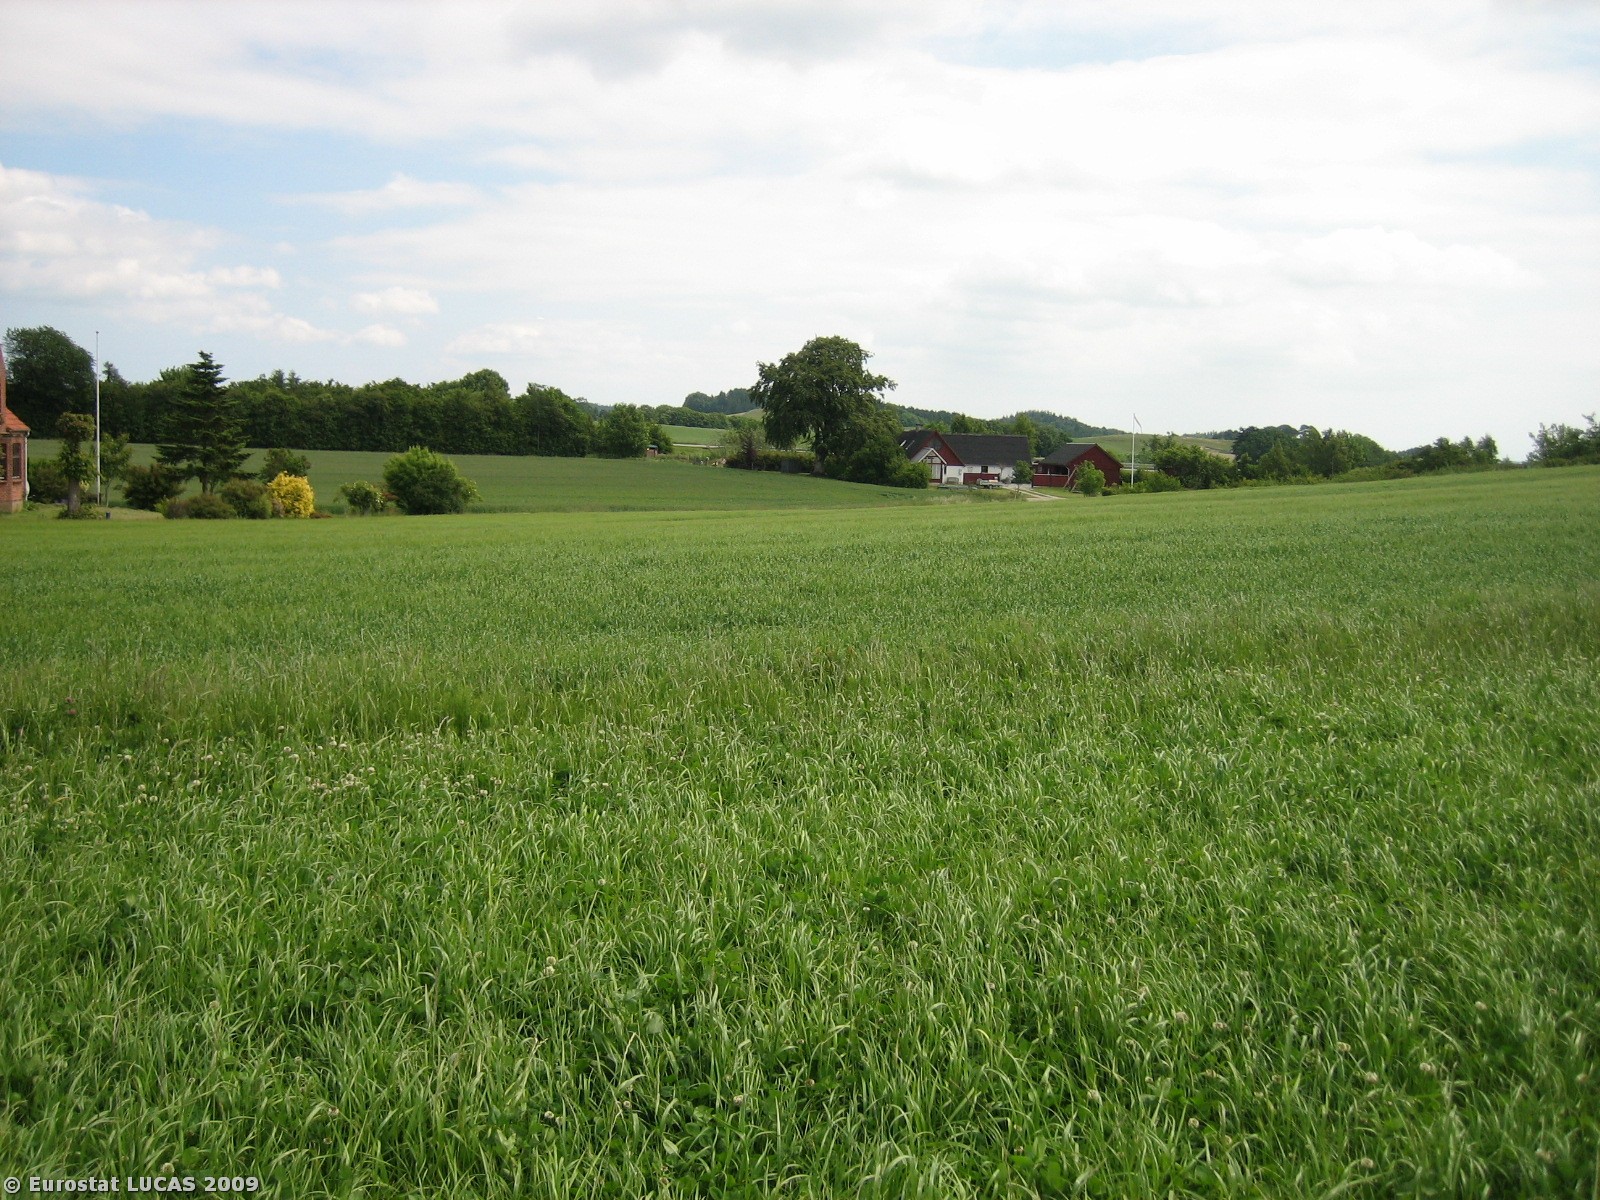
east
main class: Cropland
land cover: Temporary grasslands
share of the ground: > 75 %
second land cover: Clovers
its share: 25 - 50 %
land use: Agriculture (excluding fallow land and kitchen gardens)
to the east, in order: Temporary grasslands; Clovers; Grass margins; Barley; Grass margins; Tracks; Grass margins; Common wheat; Grass margins; Tracks; Grass margins; Fences; Grassland without tree/shrub cover; Fences; Shrubland with sparse tree cover
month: June
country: DK
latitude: 55.9001
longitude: 10.0160
